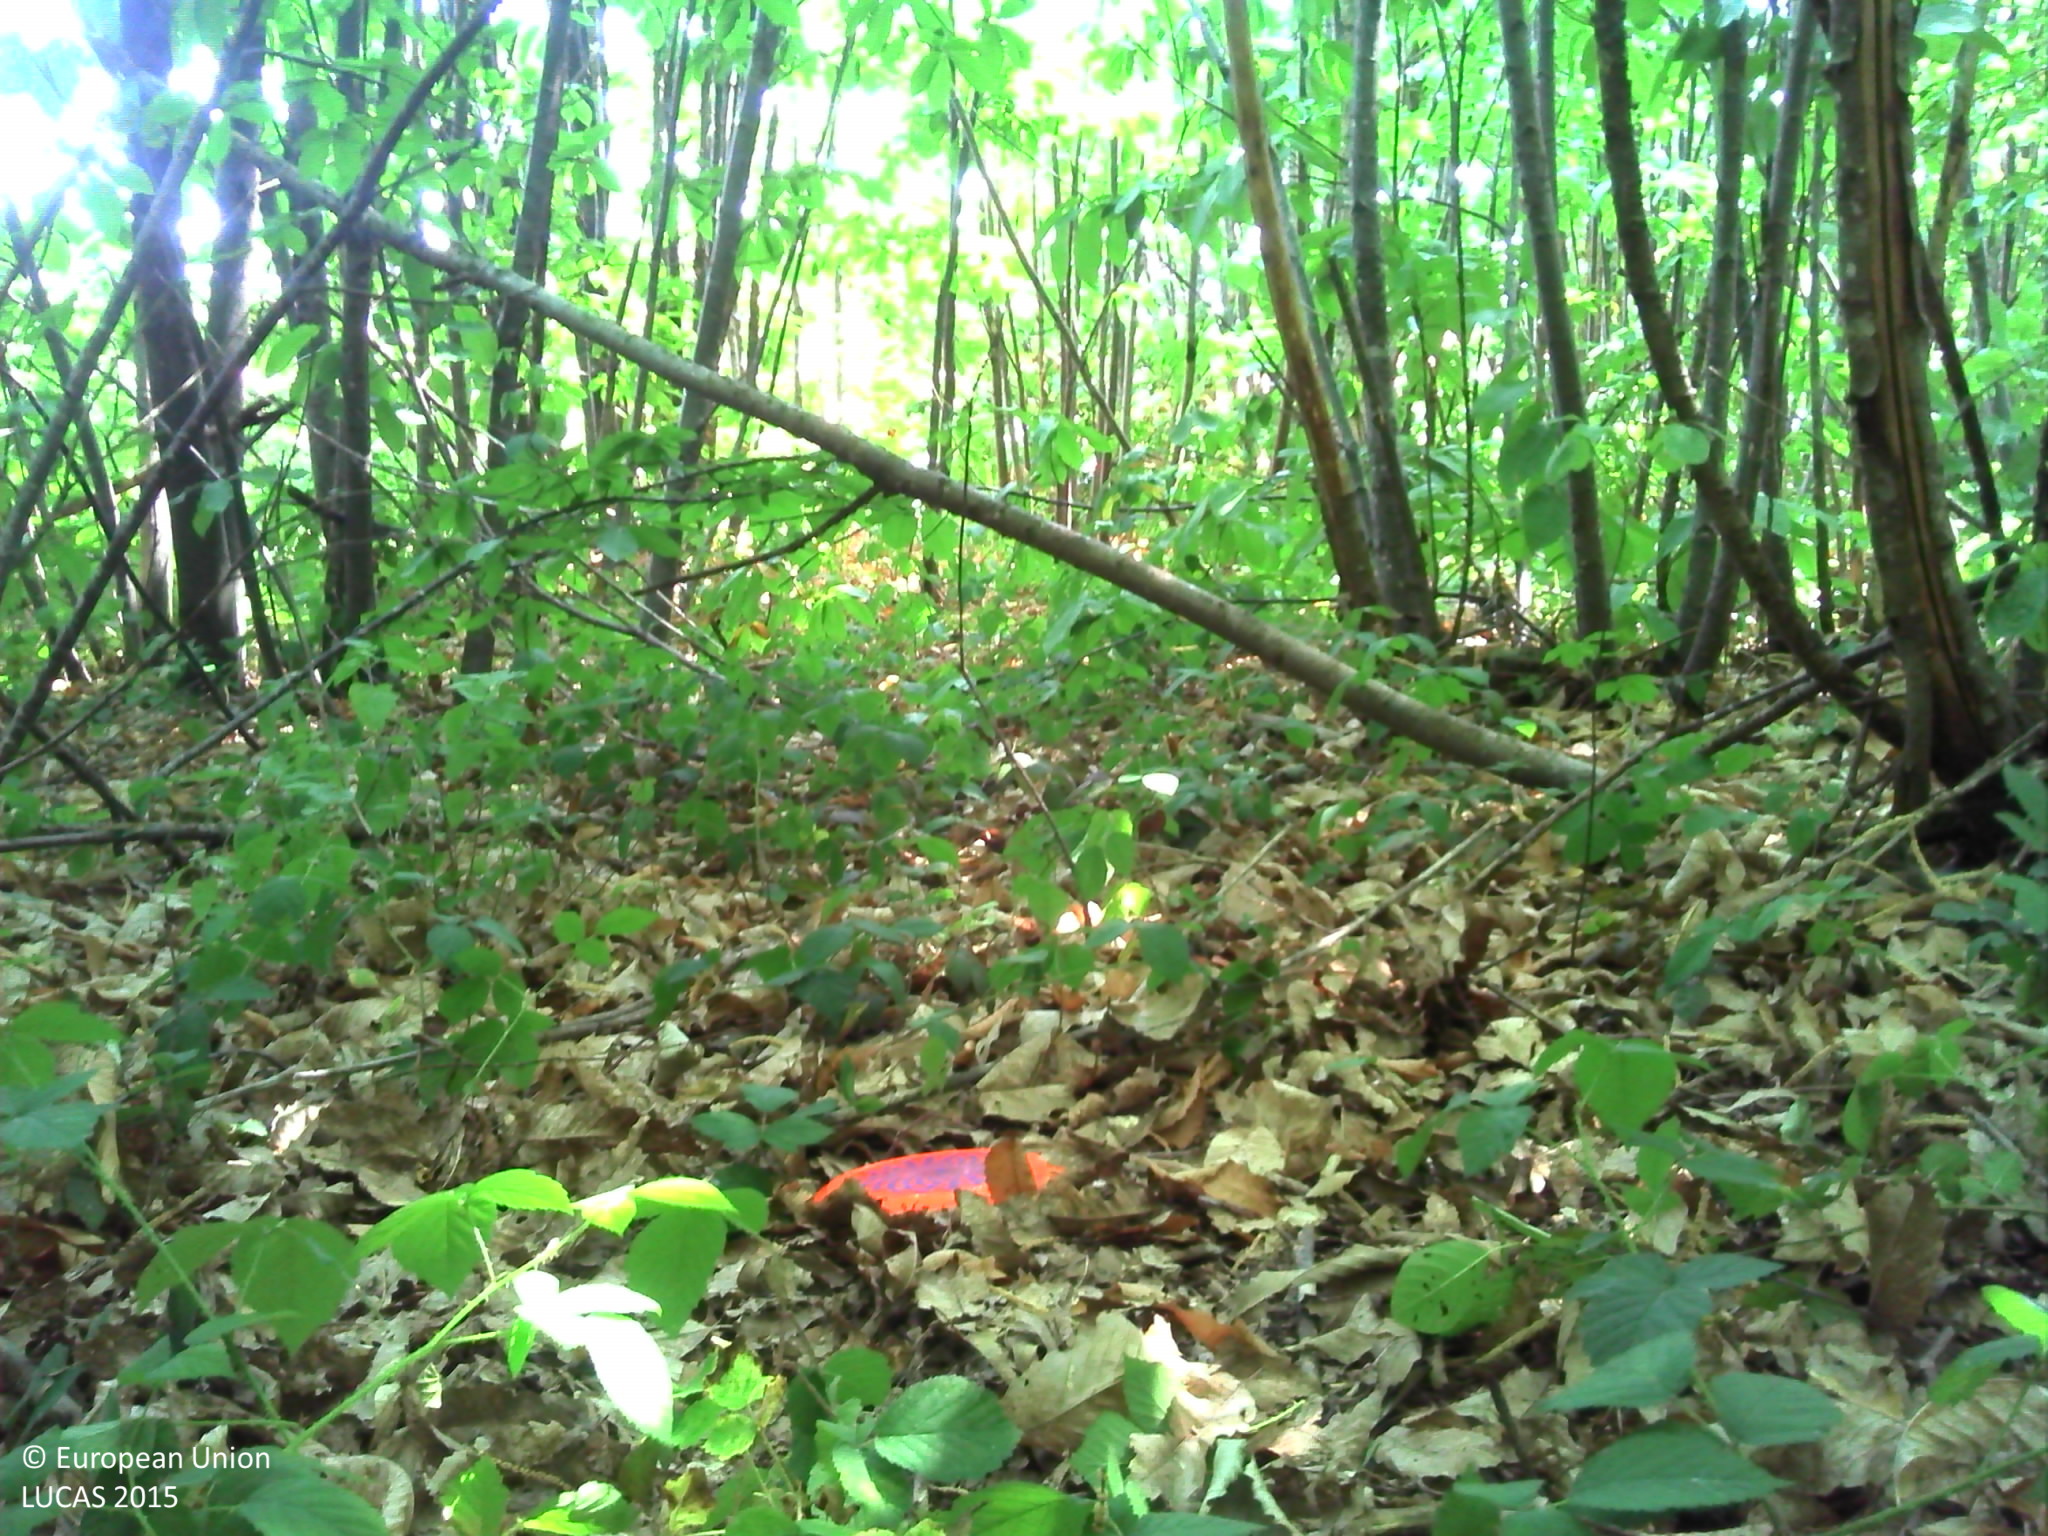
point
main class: Woodland
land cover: Broadleaved woodland
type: thermophilous deciduous forest
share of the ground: > 75 %
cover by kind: broadleaved forest trees 40 %, herbaceous plants 30 %, unconsolidated bare surface 25 %
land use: Forestry
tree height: > 5 m
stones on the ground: 10 - 25 %
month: July
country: FR
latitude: 45.6489
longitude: 1.0466
